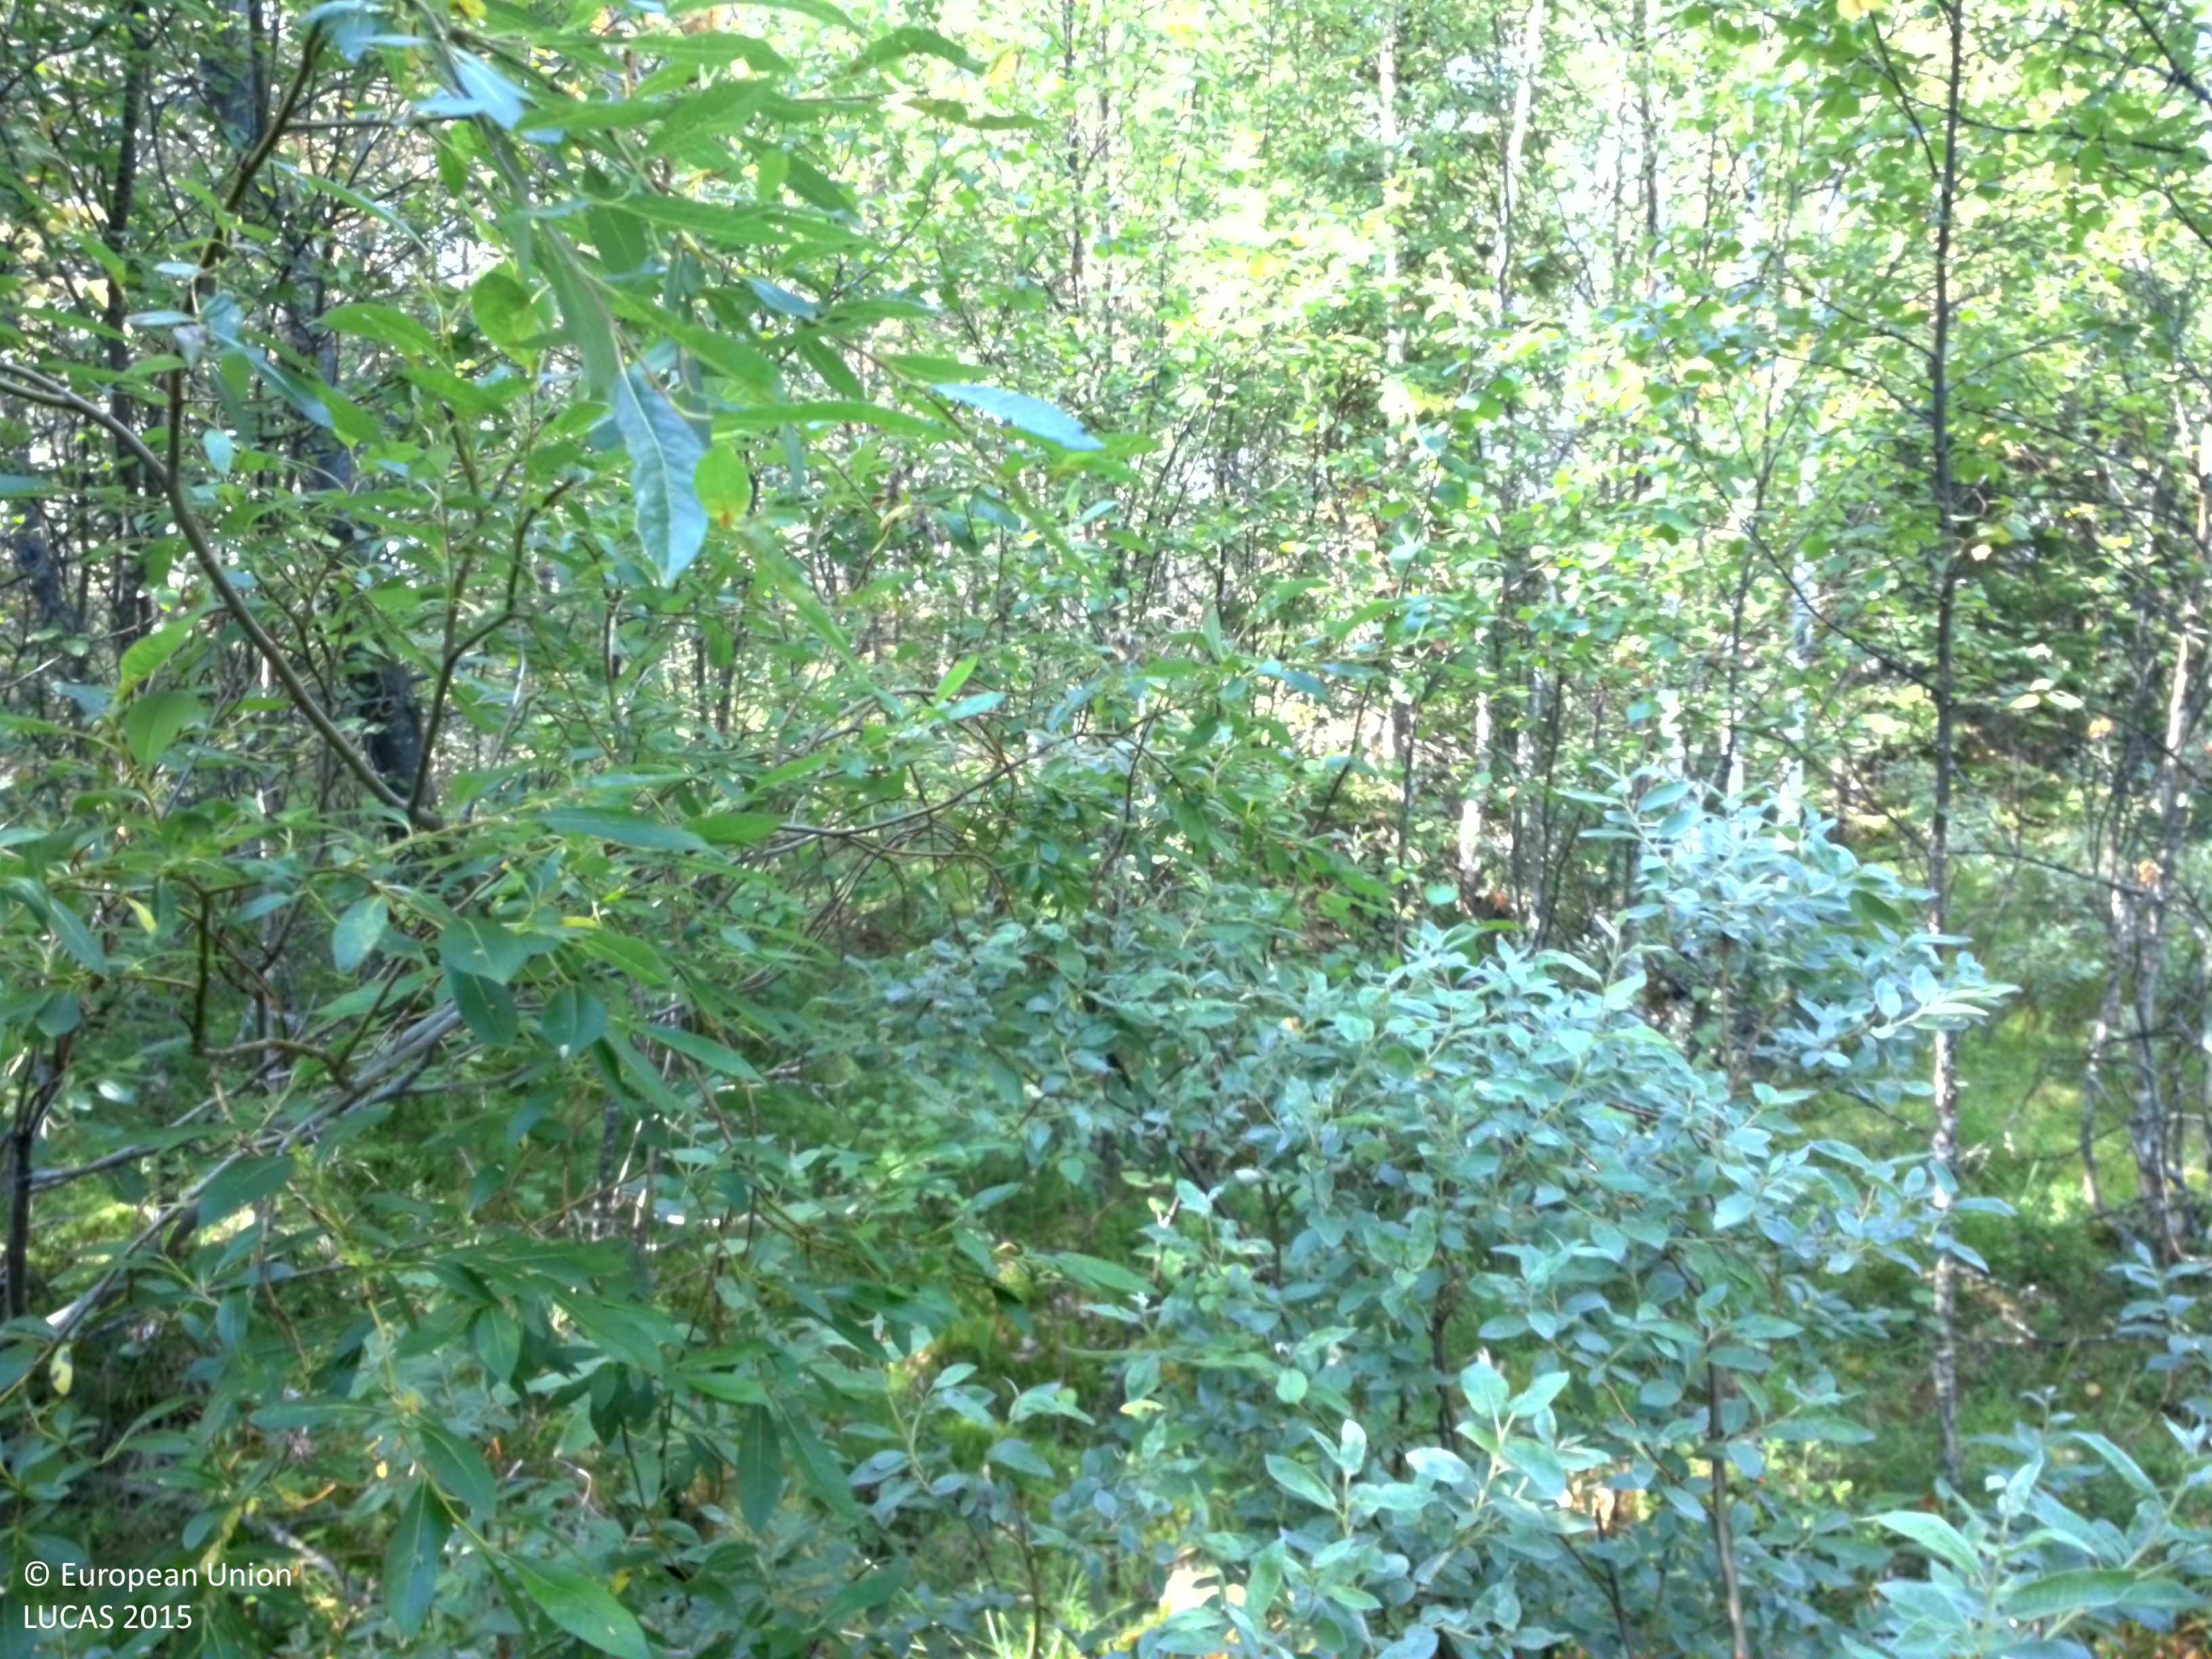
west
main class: Woodland
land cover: Broadleaved woodland
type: non-riverine alder, birch or aspen forest
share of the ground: 25 - 50 %
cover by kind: shrubs 40 %, broadleaved forest trees 35 %, coniferous forest trees 10 %, lichens and mosses 10 %, herbaceous plants 5 %
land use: Semi-natural and natural areas not in use
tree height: > 5 m
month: August
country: SE
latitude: 64.6578
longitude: 16.6463
